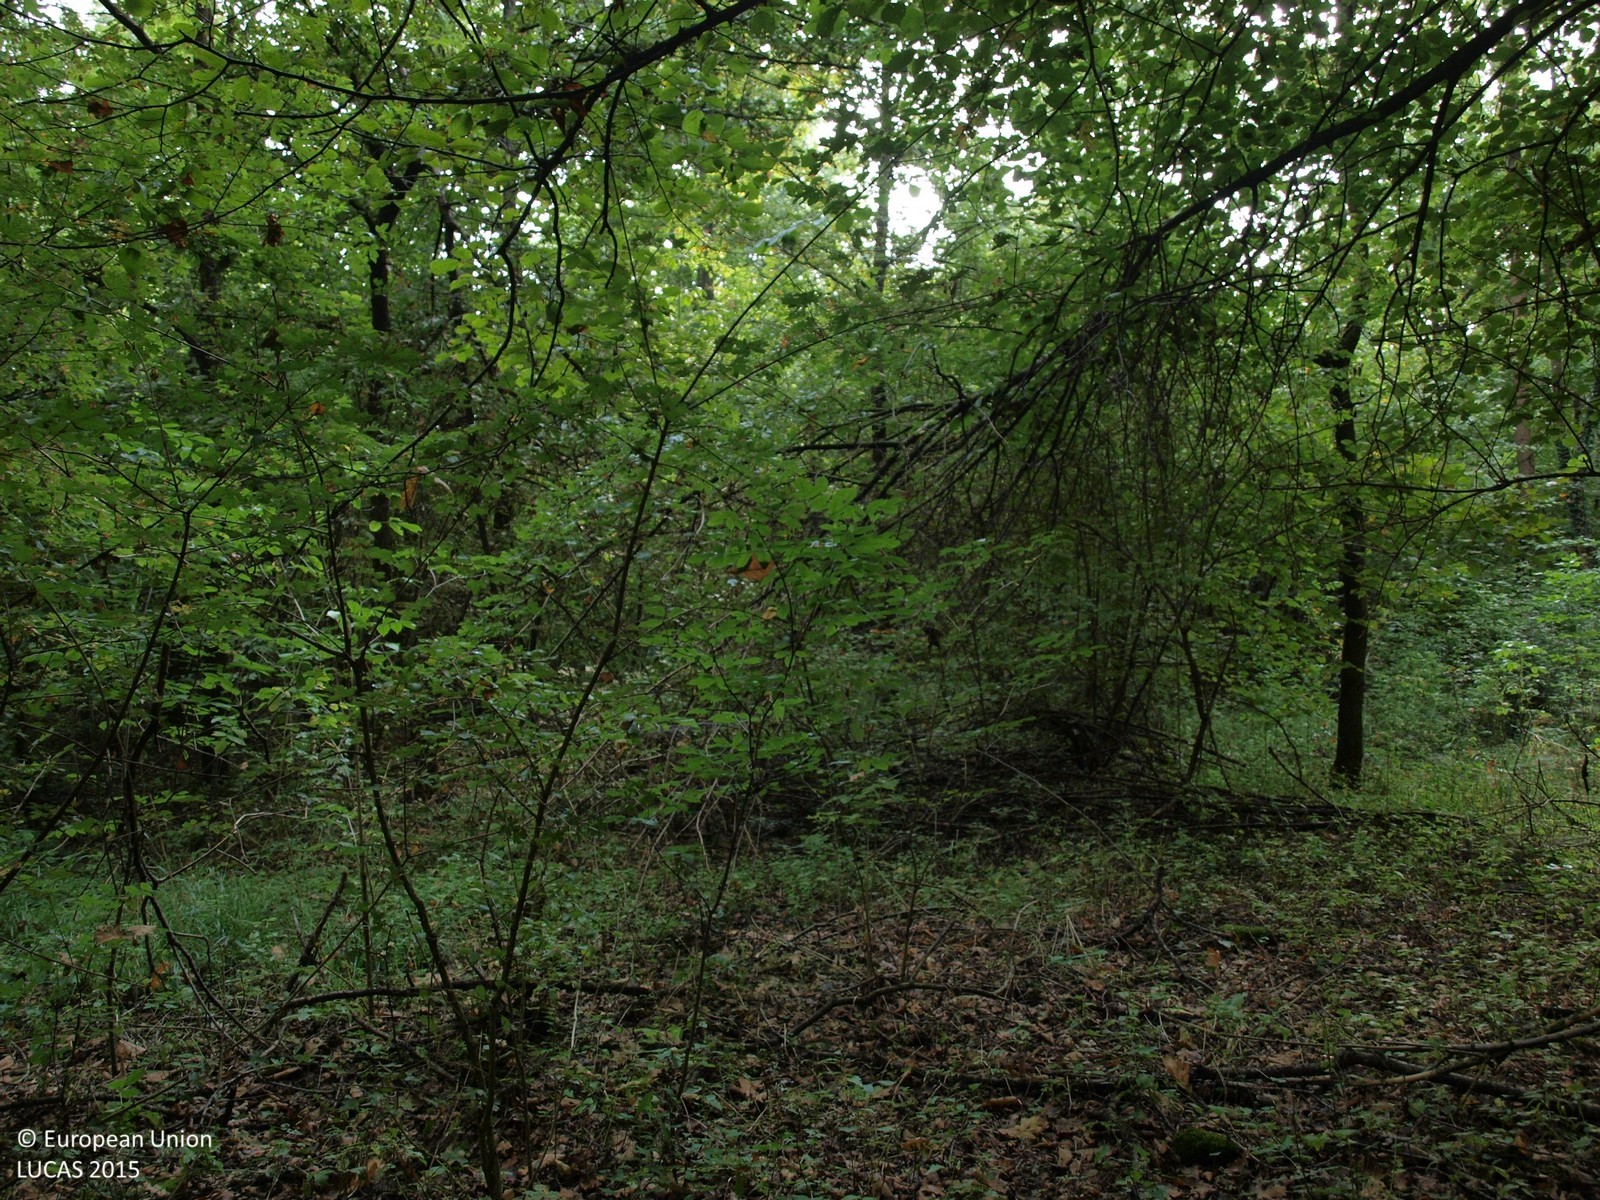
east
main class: Woodland
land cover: Broadleaved woodland
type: floodplain forest
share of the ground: > 75 %
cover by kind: broadleaved forest trees 100 %
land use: Forestry
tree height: > 5 m
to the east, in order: Broadleaved woodland; Tracks; Ditches and canals; Broadleaved woodland
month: September
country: HR
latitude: 45.7419
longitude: 16.1288
